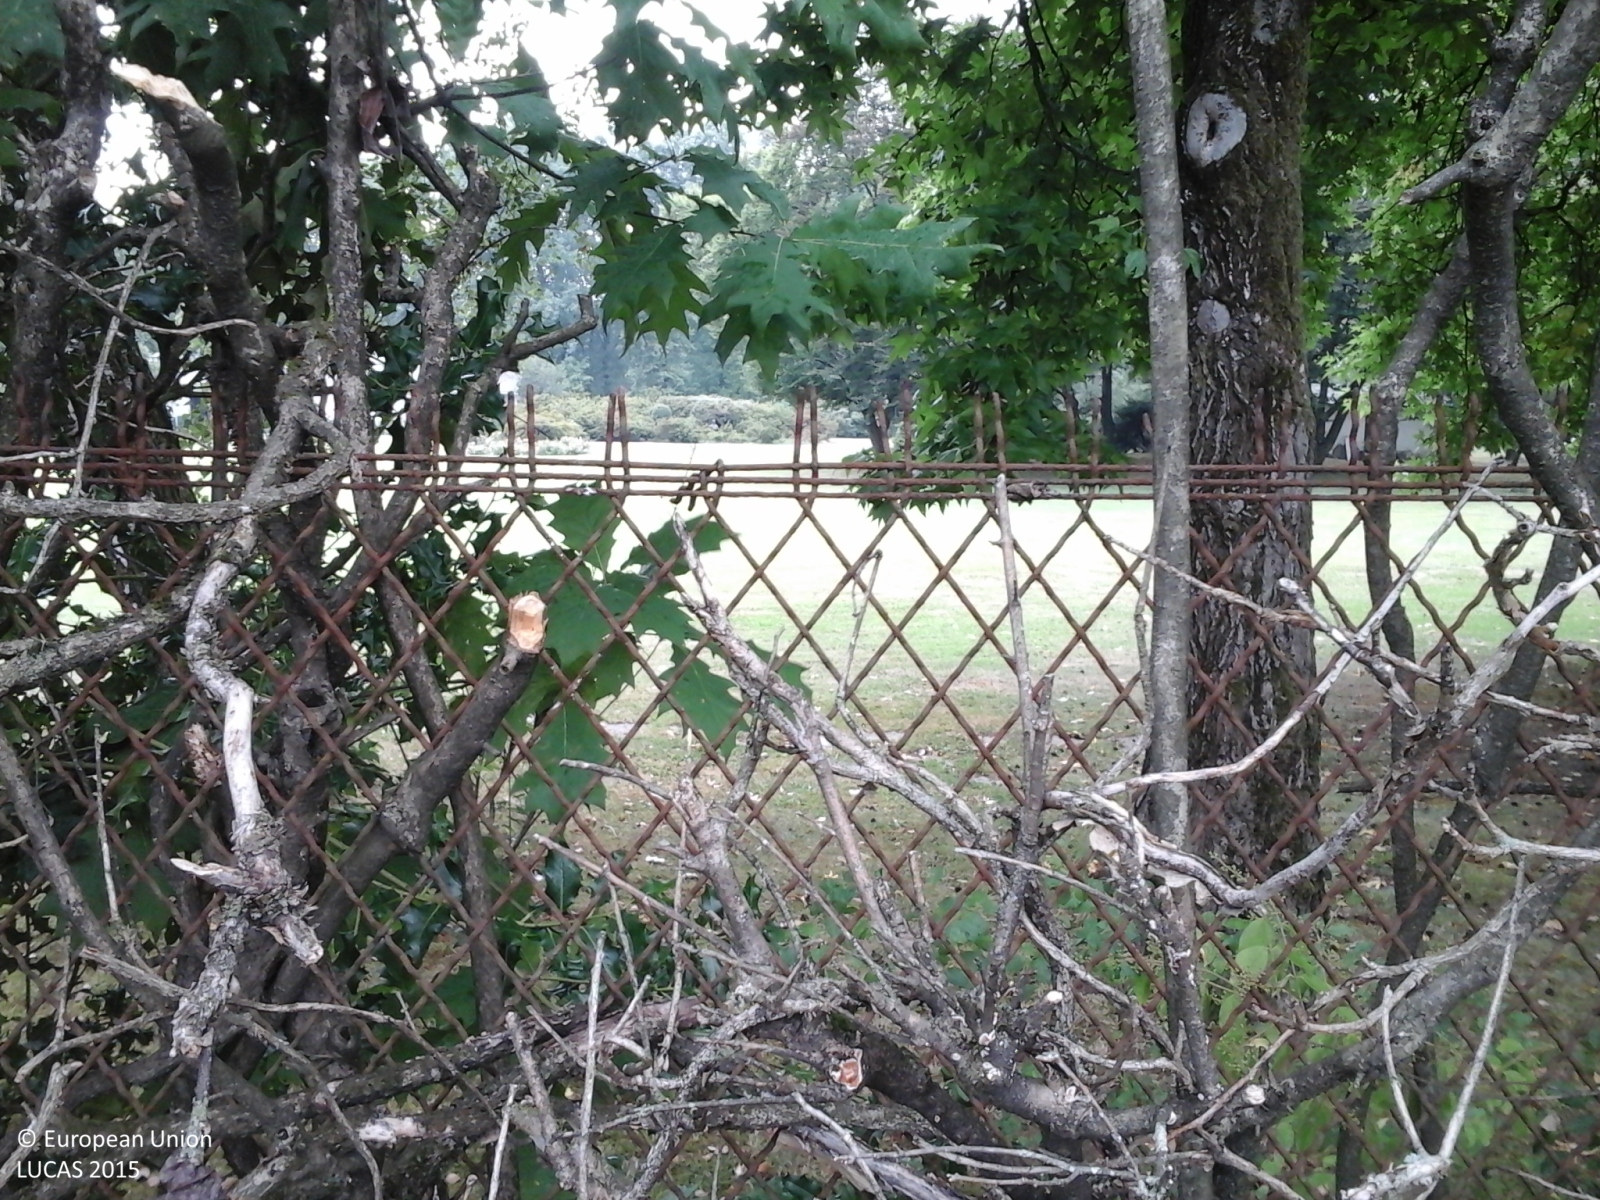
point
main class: Grassland
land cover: Grassland without tree/shrub cover
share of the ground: > 75 %
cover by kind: herbaceous plants 100 %
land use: Residential
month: August
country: IT
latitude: 45.6629
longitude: 9.1158
